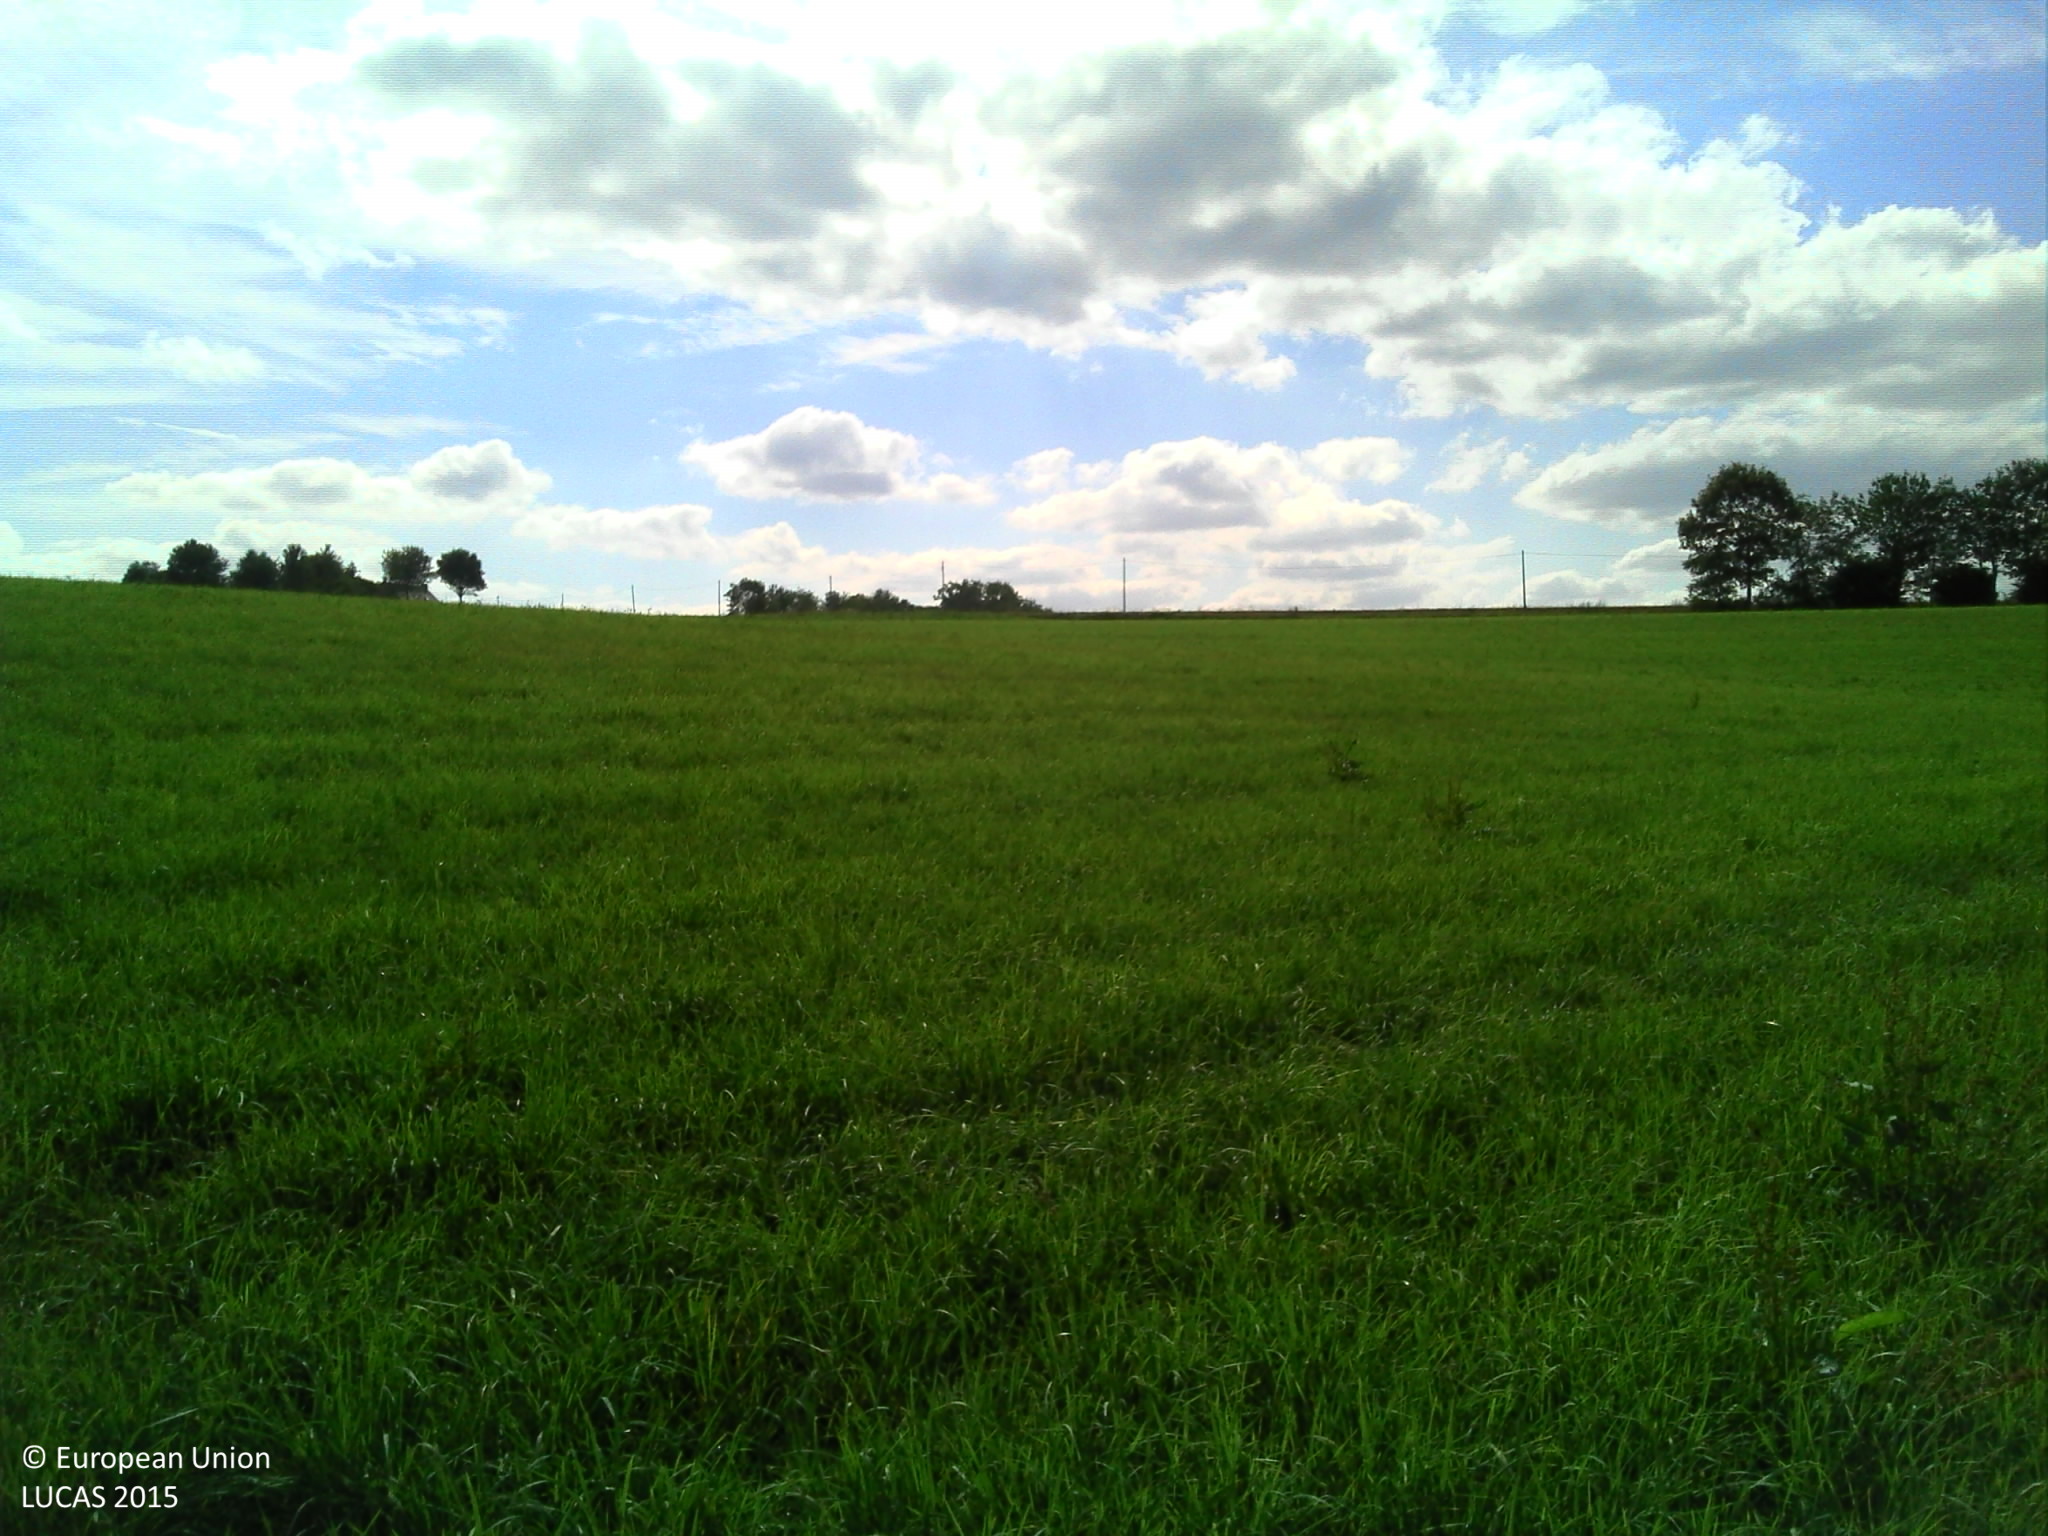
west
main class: Cropland
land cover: Temporary grasslands
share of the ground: > 75 %
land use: Agriculture (excluding fallow land and kitchen gardens)
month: July
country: FR
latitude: 48.2621
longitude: -2.4395
